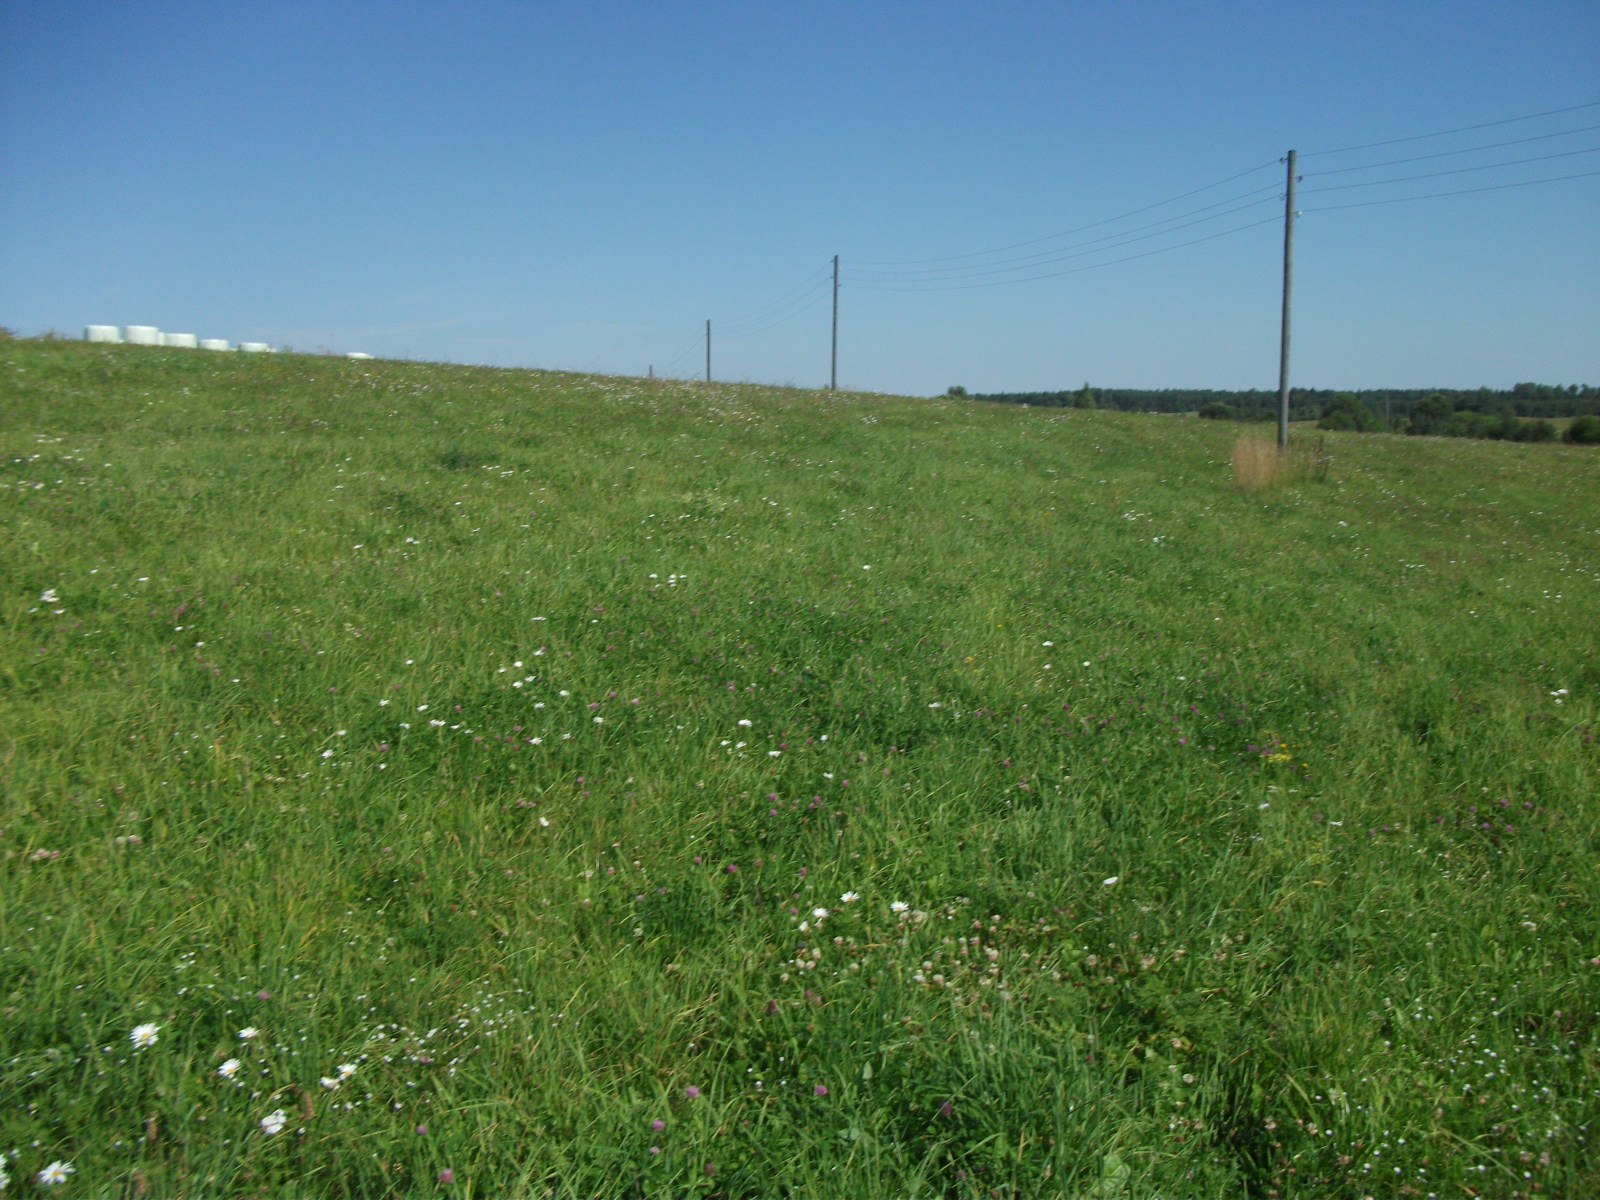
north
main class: Grassland
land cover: Grassland without tree/shrub cover
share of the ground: > 75 %
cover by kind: herbaceous plants 100 %
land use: Agriculture (excluding fallow land and kitchen gardens)
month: August
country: LV
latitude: 56.9284
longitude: 25.7845
